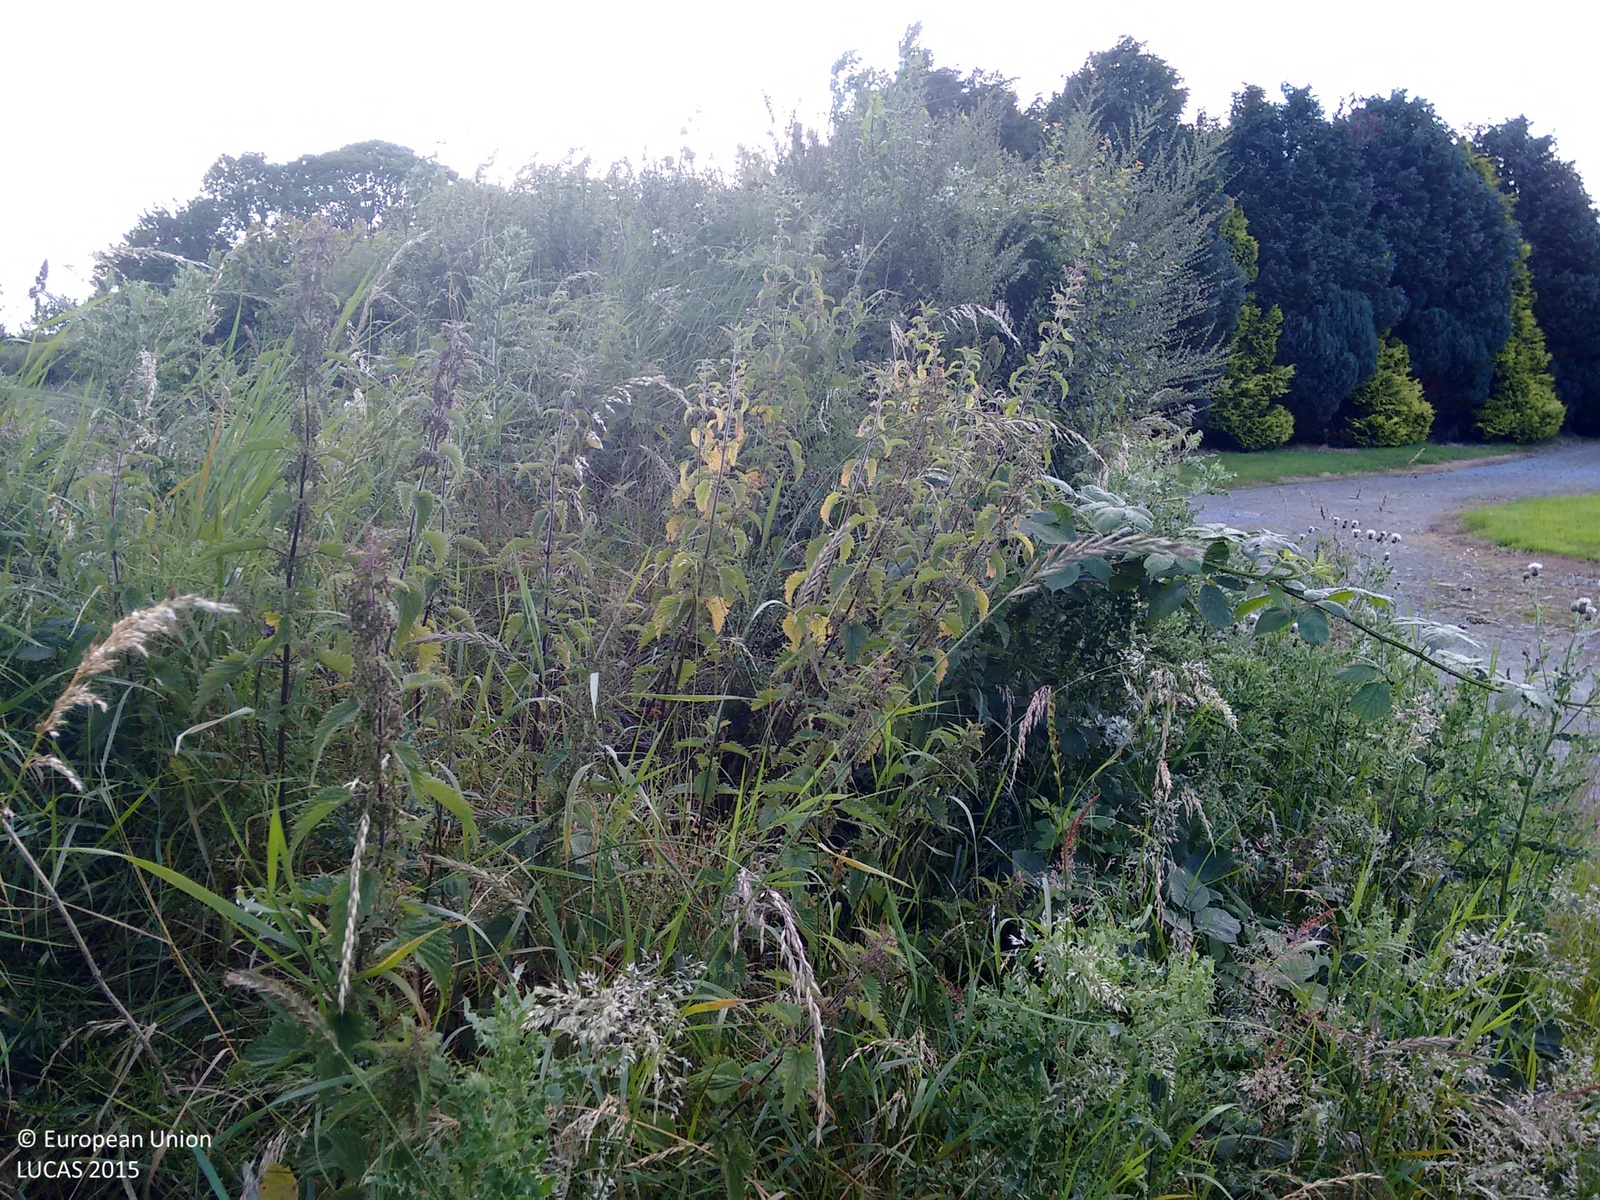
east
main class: Cropland
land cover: Barley
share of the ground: > 75 %
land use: Agriculture (excluding fallow land and kitchen gardens)
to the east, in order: Barley; Grass margins; Abandoned hedges; Barley; Grass margins; Electric lines; Barley; Grass margins; Managed hedges; Paved roads, cycling and walking lanes
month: July
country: IE
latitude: 52.2203
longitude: -8.9323
